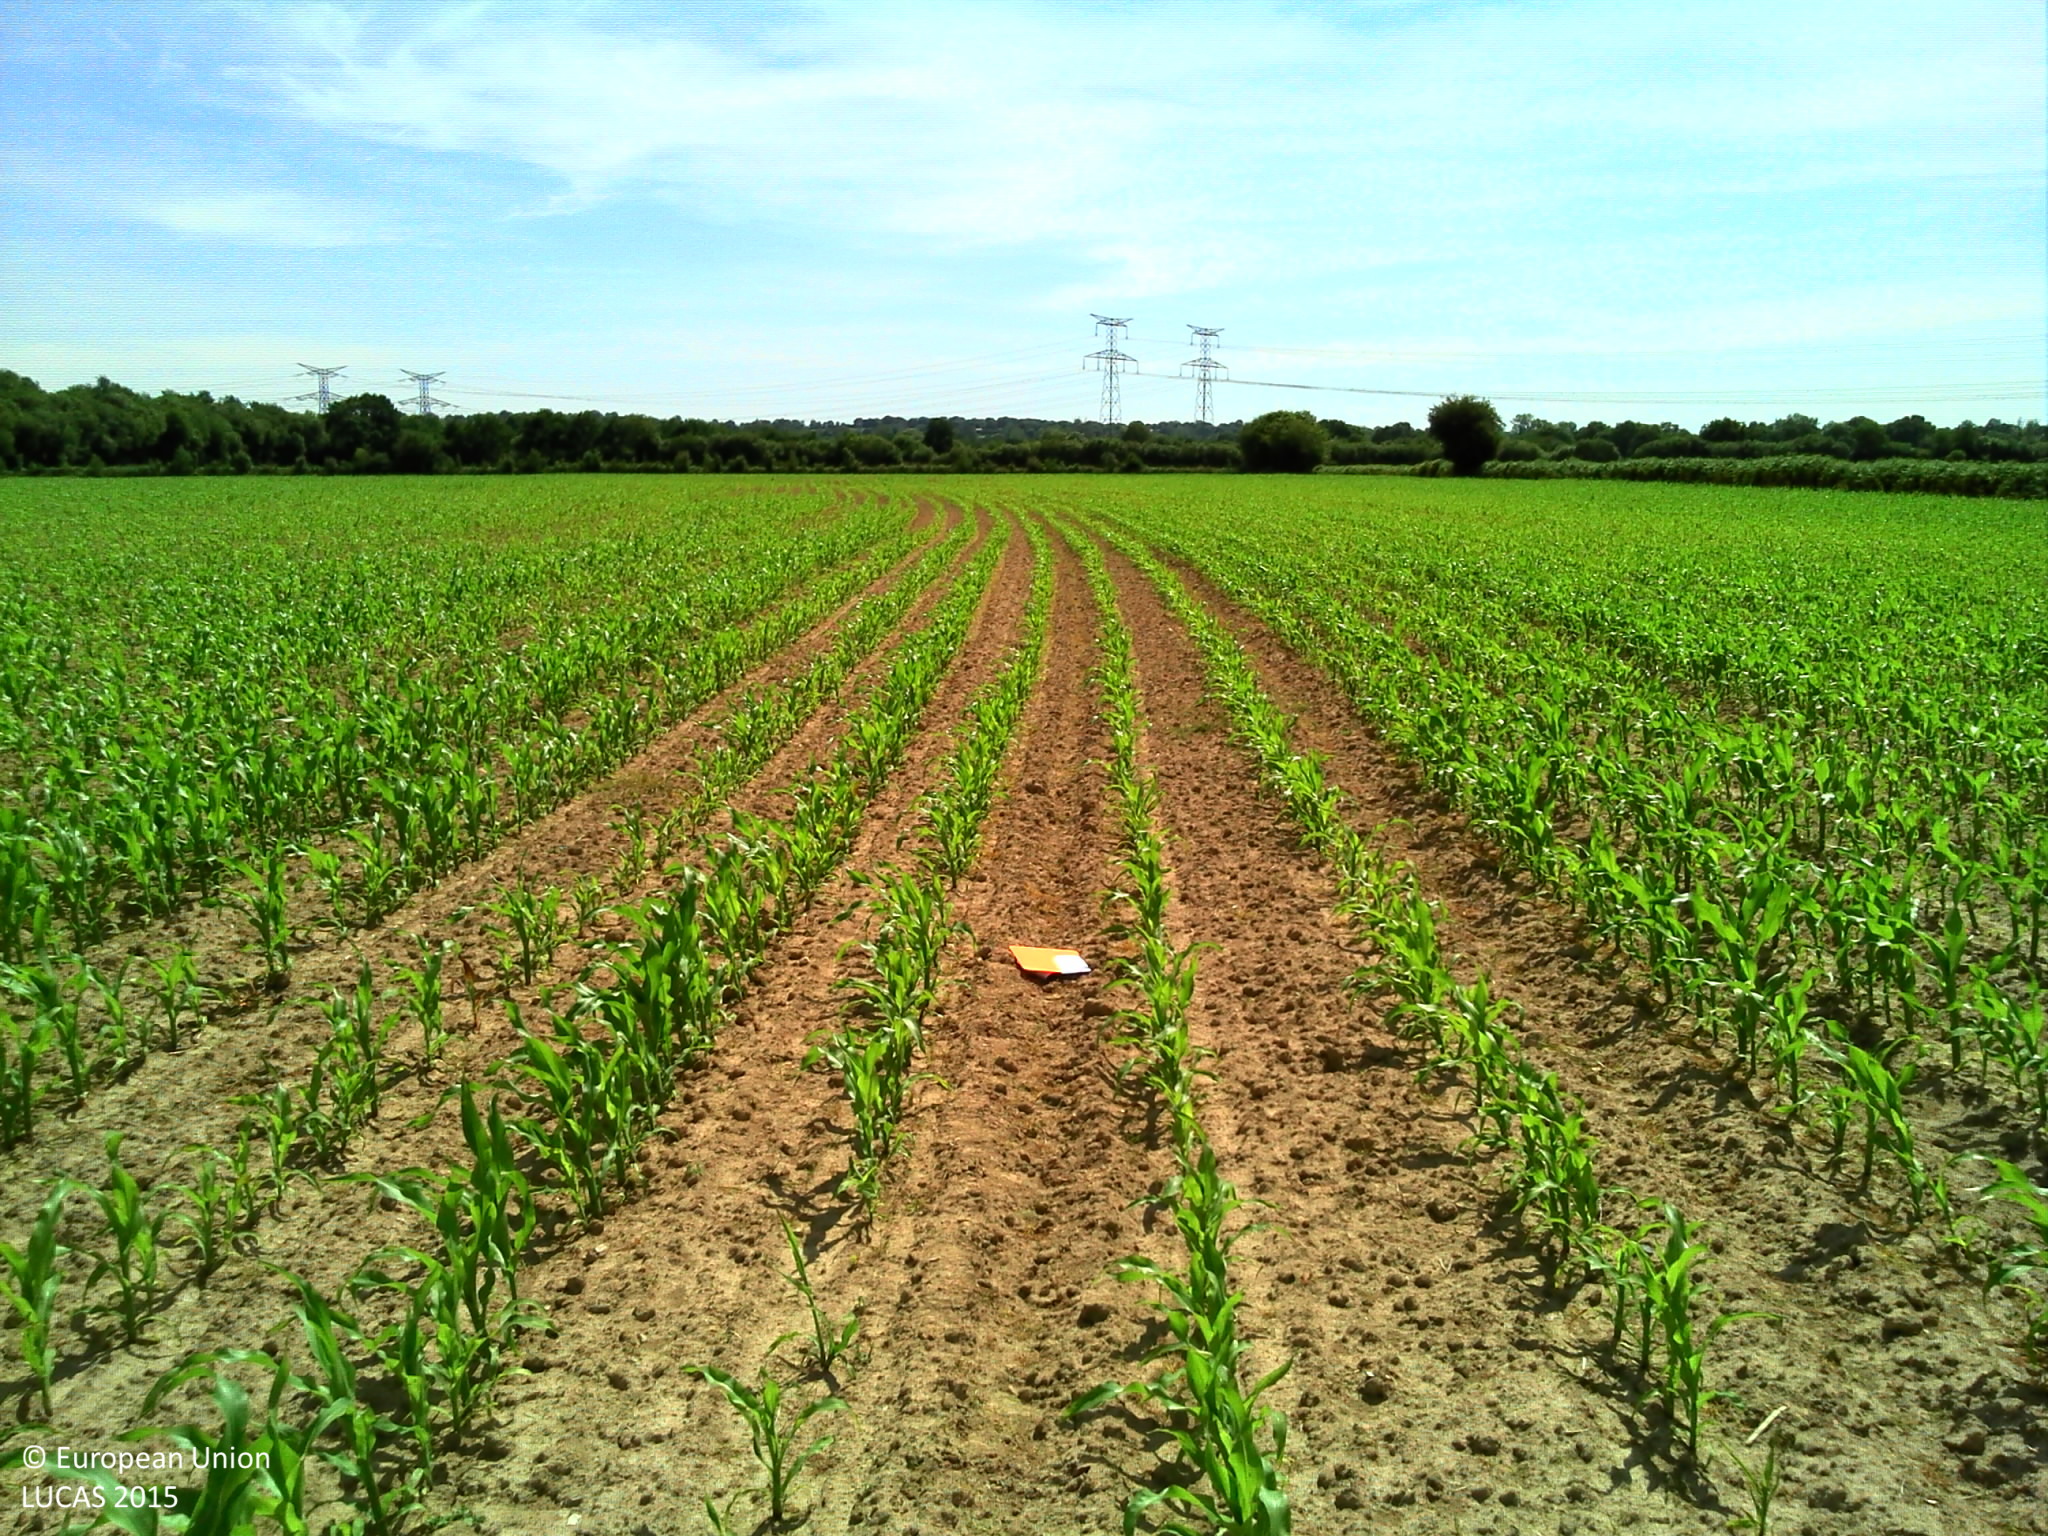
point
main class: Cropland
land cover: Maize
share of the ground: 25 - 50 %
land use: Agriculture (excluding fallow land and kitchen gardens)
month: June
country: FR
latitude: 49.1808
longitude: -1.3371
